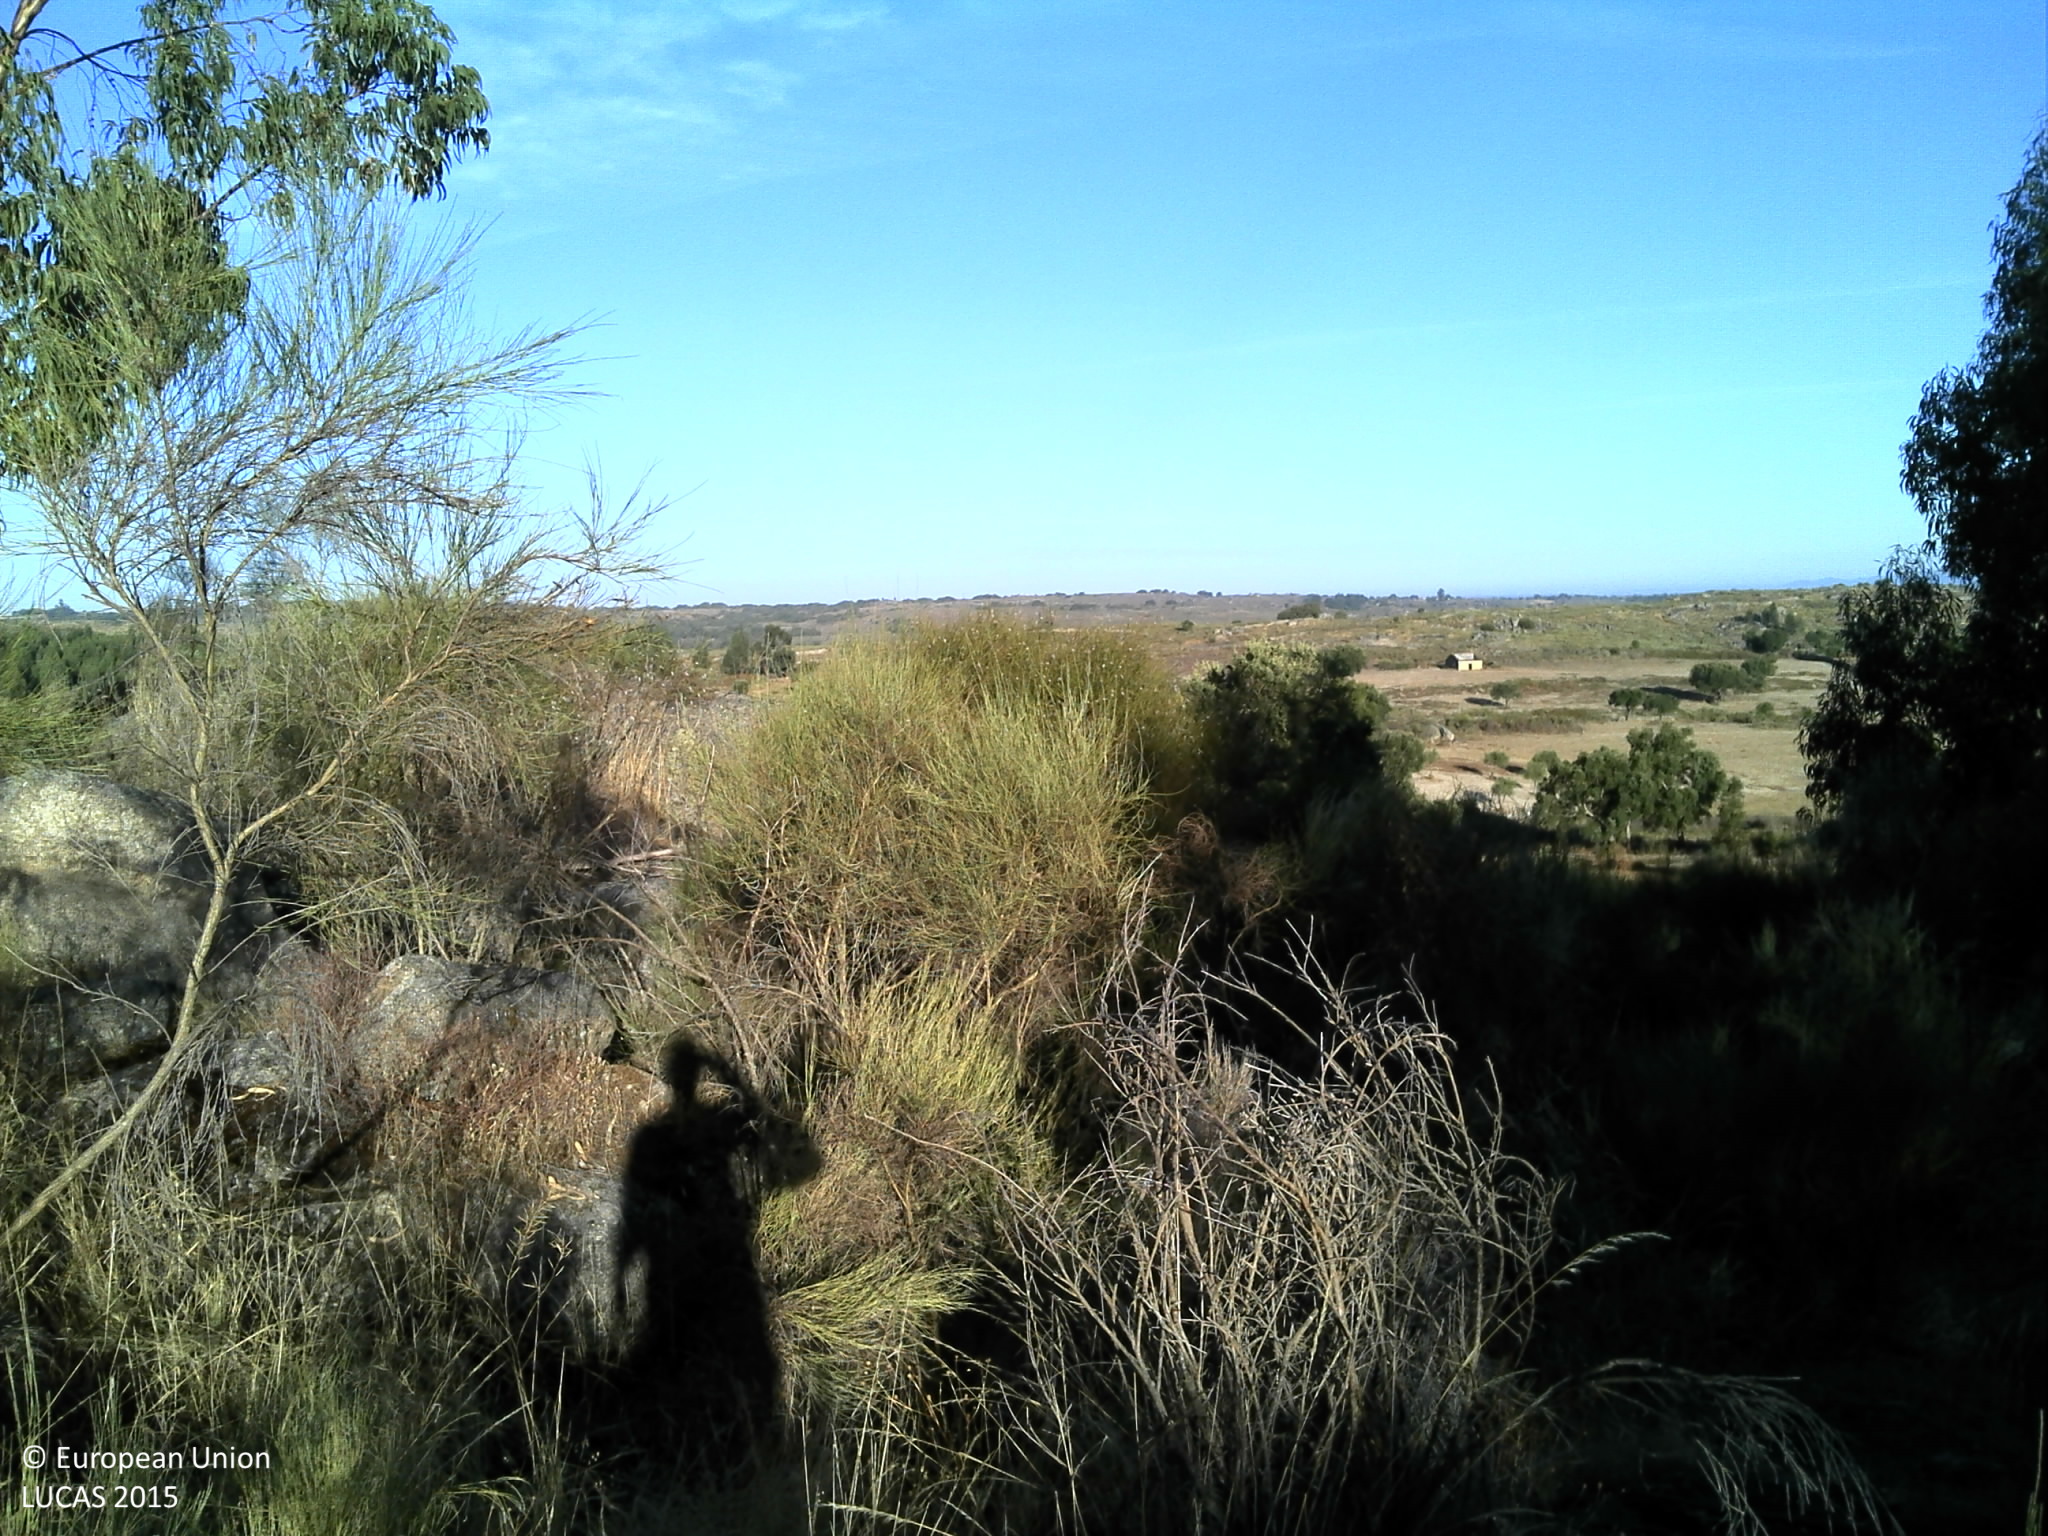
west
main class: Woodland
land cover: Broadleaved woodland
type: broadleaved evergreen forest
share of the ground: 10 - 25 %
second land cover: Shrubland without tree cover
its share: 25 - 50 %
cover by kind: shrubs 45 %, consolidated bare surface 20 %, broadleaved forest trees 15 %, herbaceous plants 15 %, unconsolidated bare surface 5 %
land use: Forestry
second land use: Agriculture (excluding fallow land and kitchen gardens)
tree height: > 5 m
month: August
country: PT
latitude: 39.4536
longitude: -7.5130
